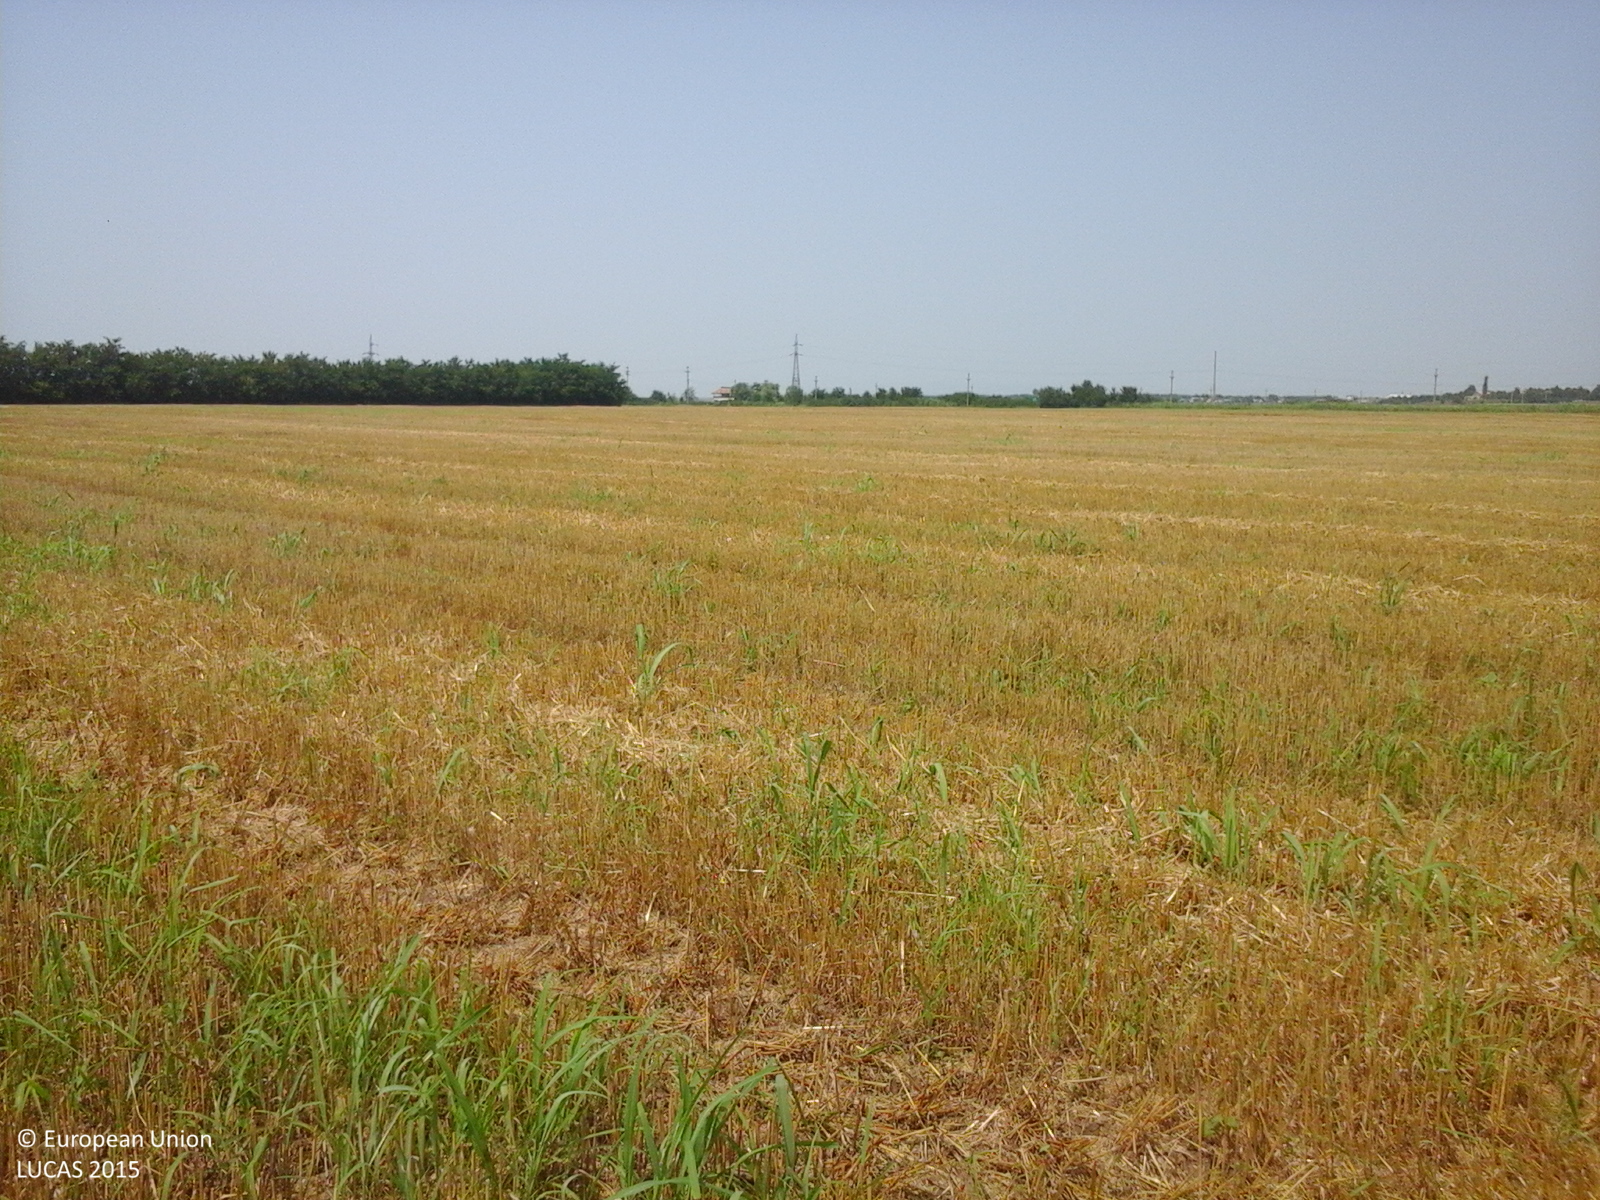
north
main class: Cropland
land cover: Common wheat
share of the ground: 25 - 50 %
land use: Agriculture (excluding fallow land and kitchen gardens)
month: July
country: RO
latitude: 44.7343
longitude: 26.5738
